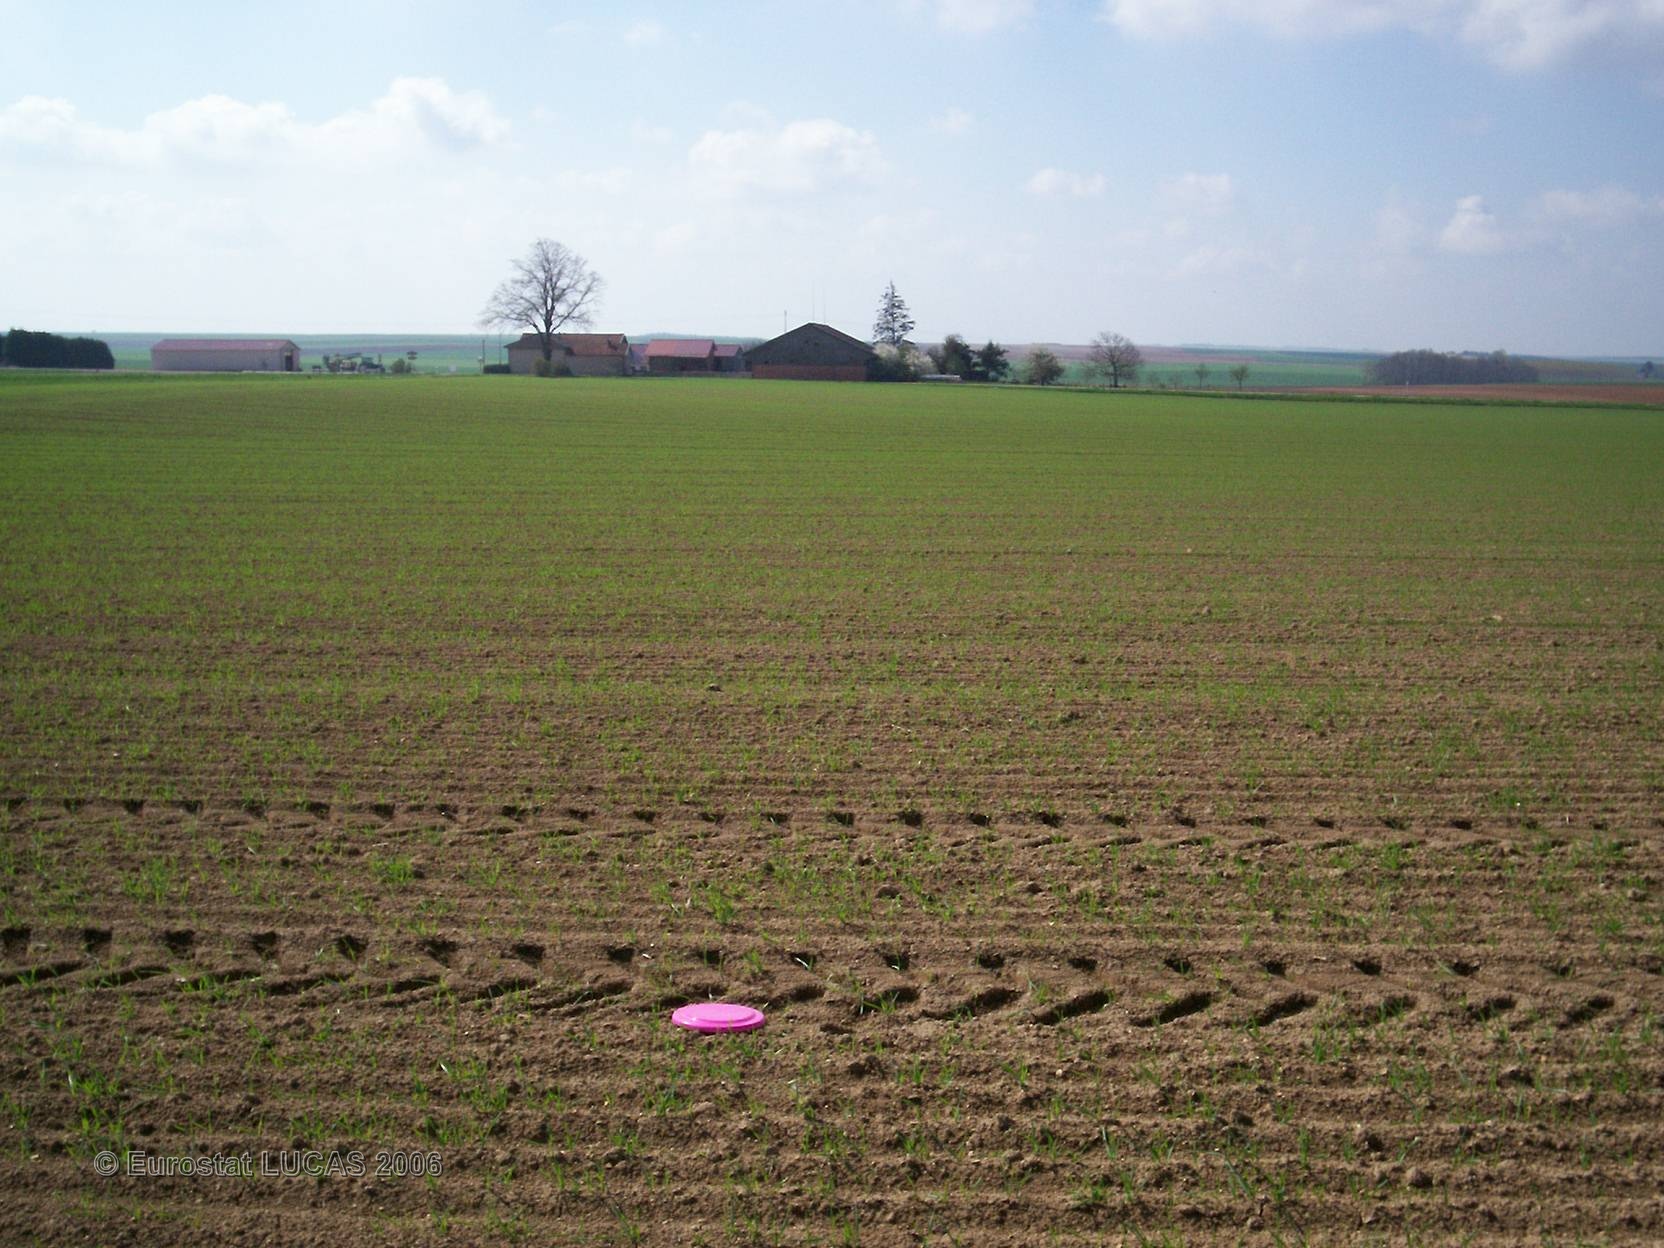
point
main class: Cropland
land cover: Barley
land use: Agriculture (excluding fallow land and kitchen gardens)
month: April
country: FR
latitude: 48.5198
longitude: 4.5140
